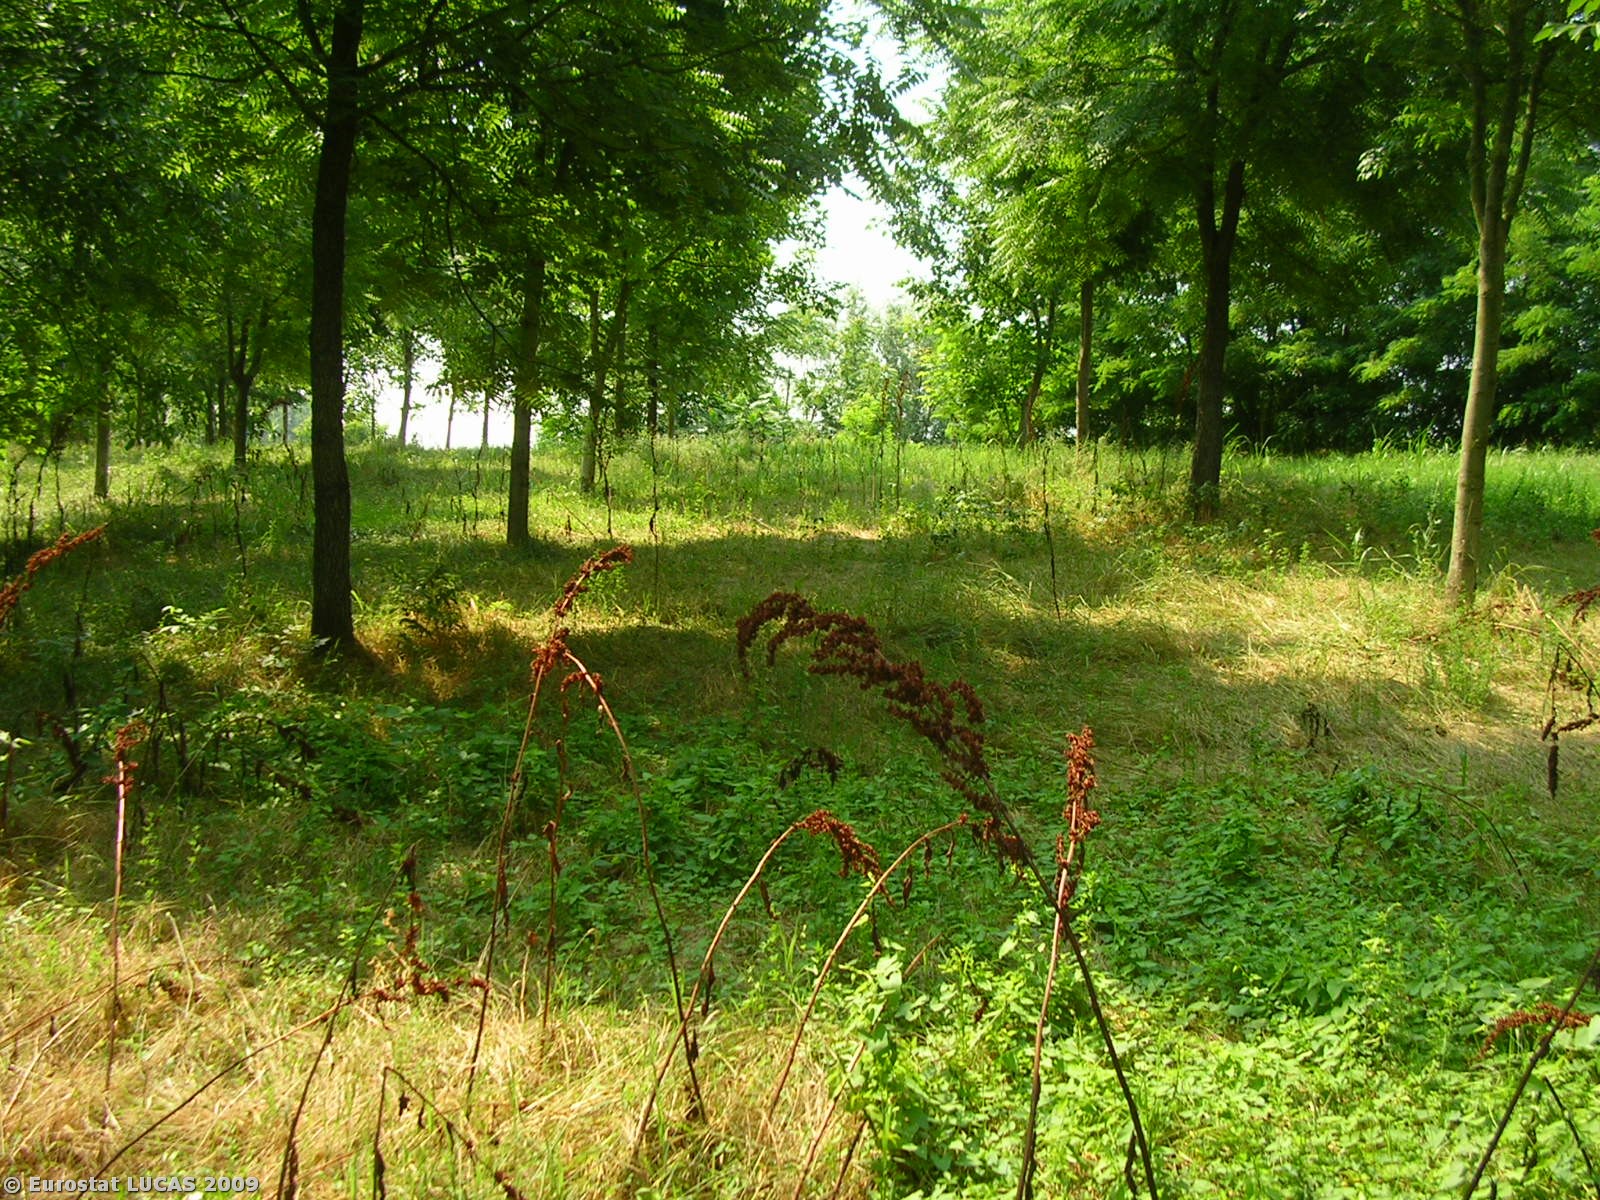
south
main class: Woodland
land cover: Broadleaved woodland
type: non-riverine alder, birch or aspen forest
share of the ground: > 75 %
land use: Agriculture (excluding fallow land and kitchen gardens)
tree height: > 5 m
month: July
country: IT
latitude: 45.2213
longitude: 11.6399
